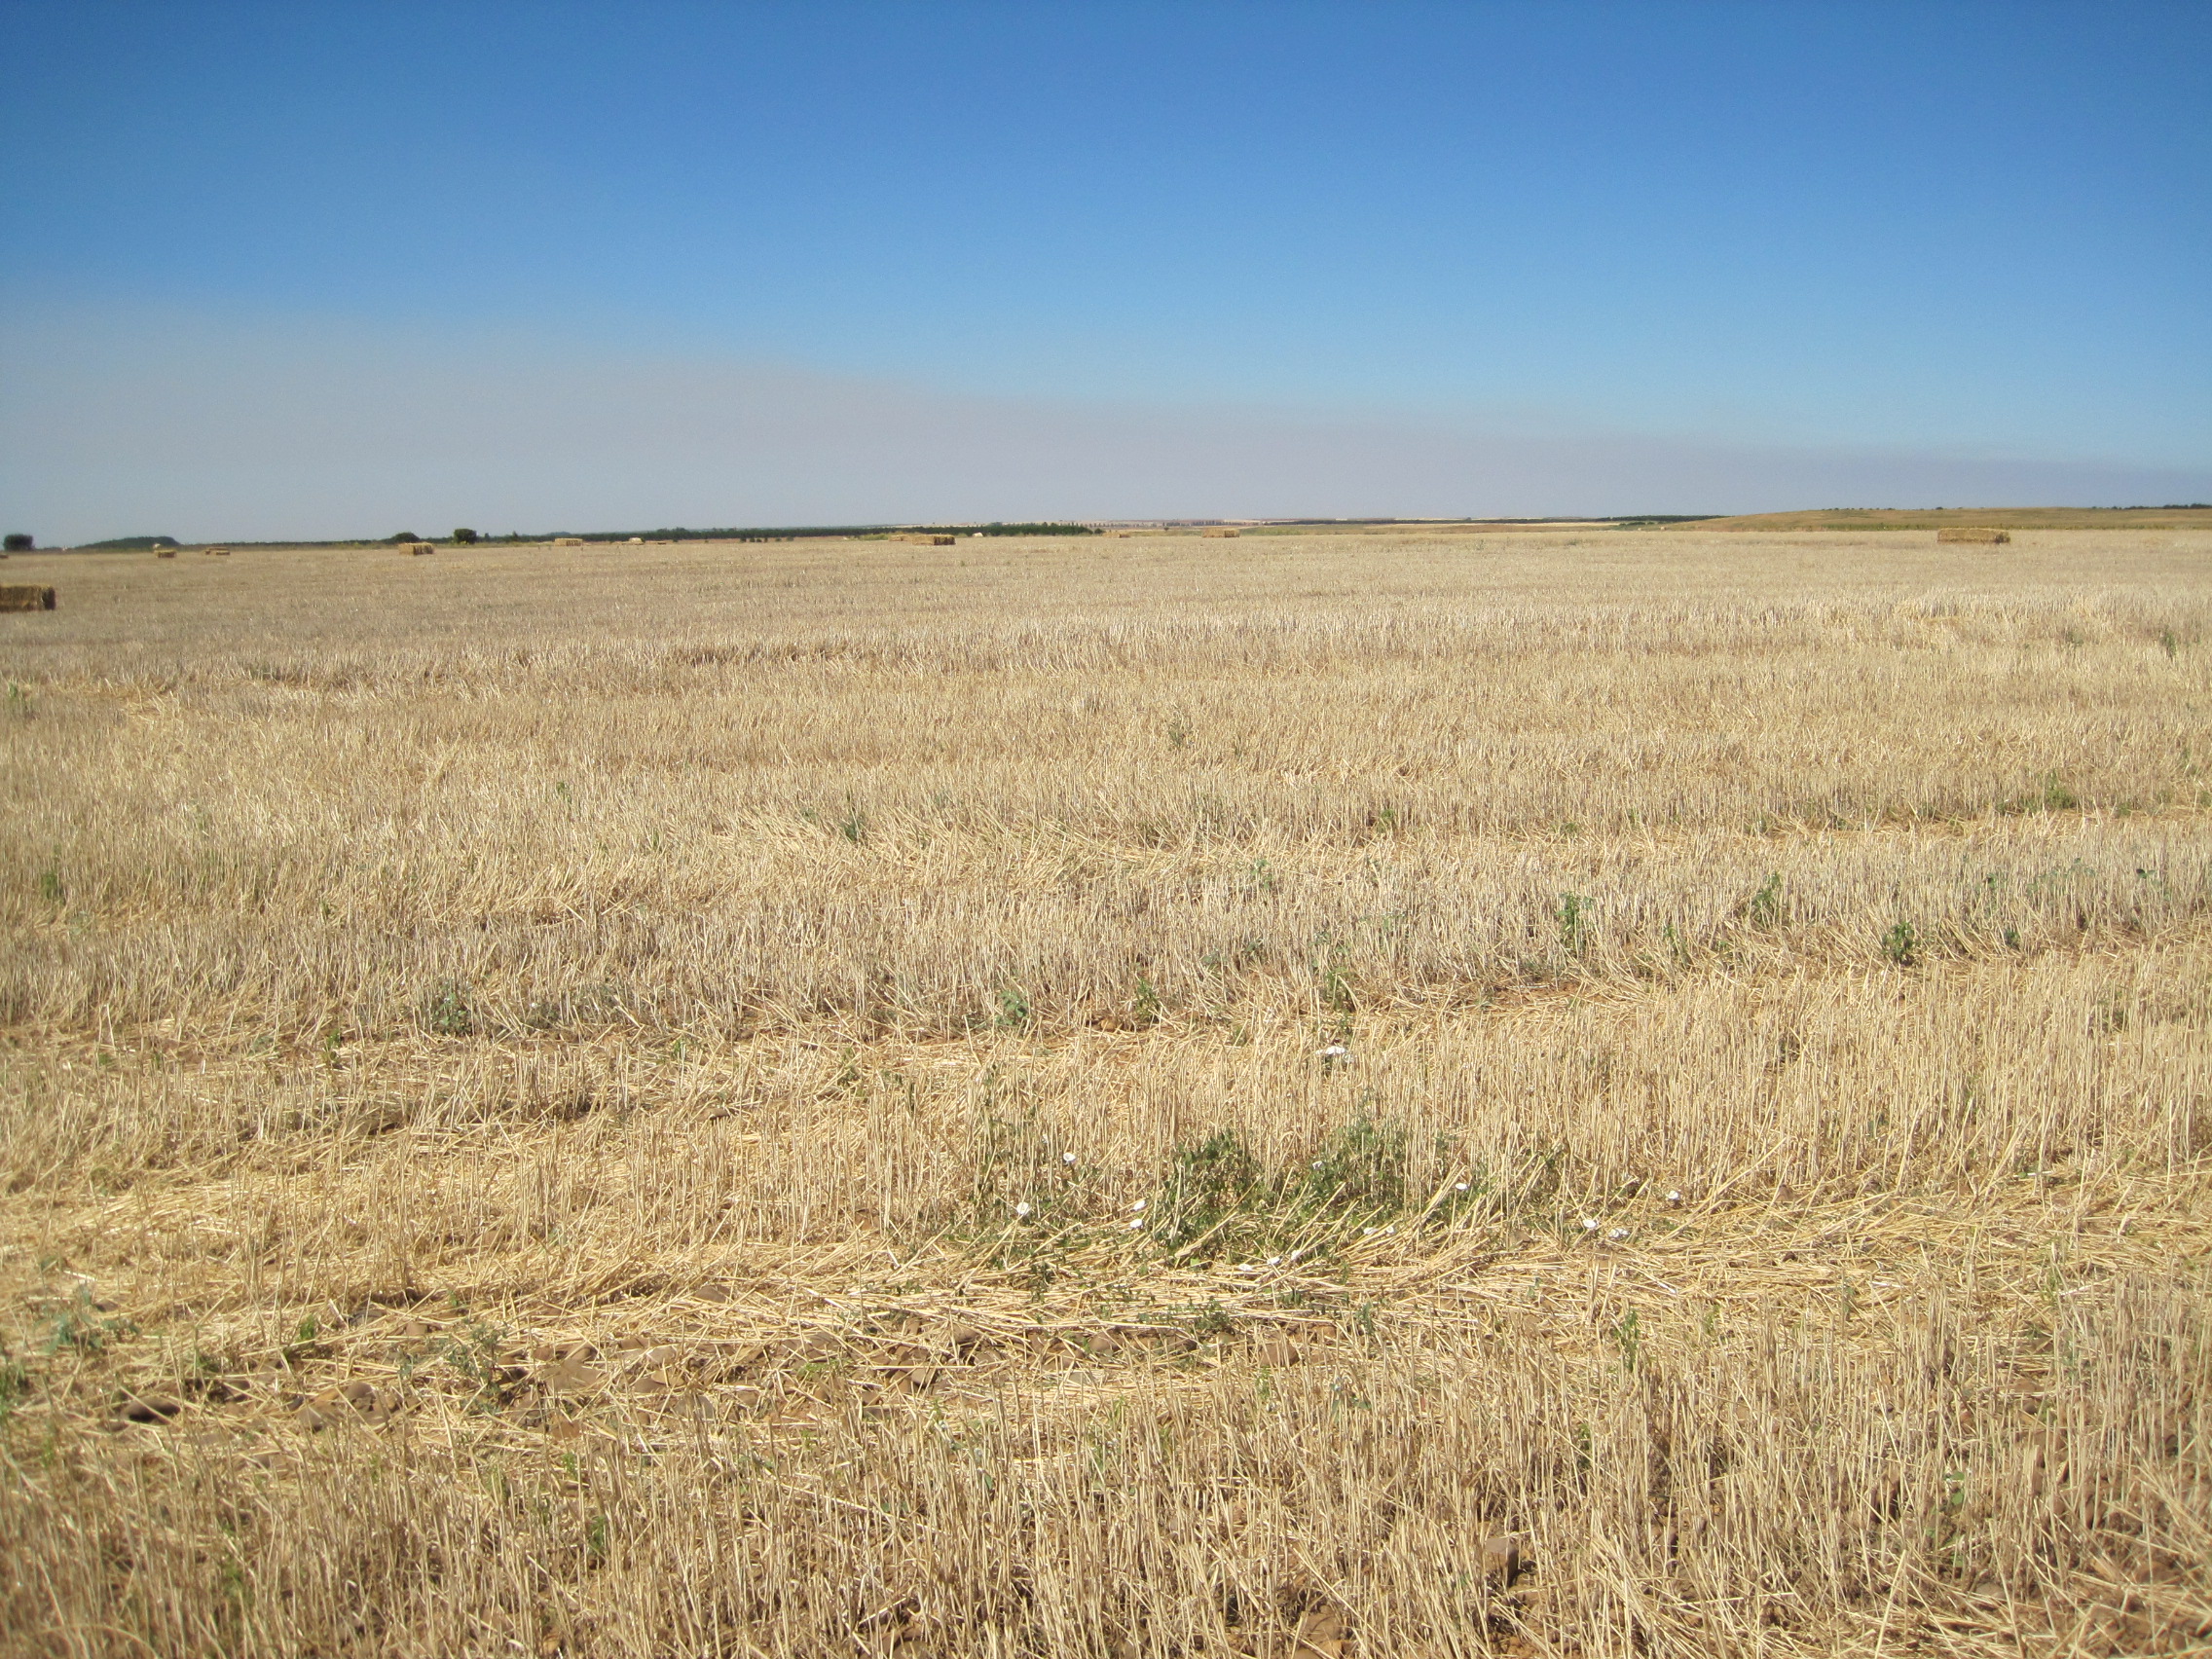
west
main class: Cropland
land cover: Common wheat
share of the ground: < 10 %
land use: Agriculture (excluding fallow land and kitchen gardens)
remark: Harvested field
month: July
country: ES
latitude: 42.1588
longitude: -5.3242
